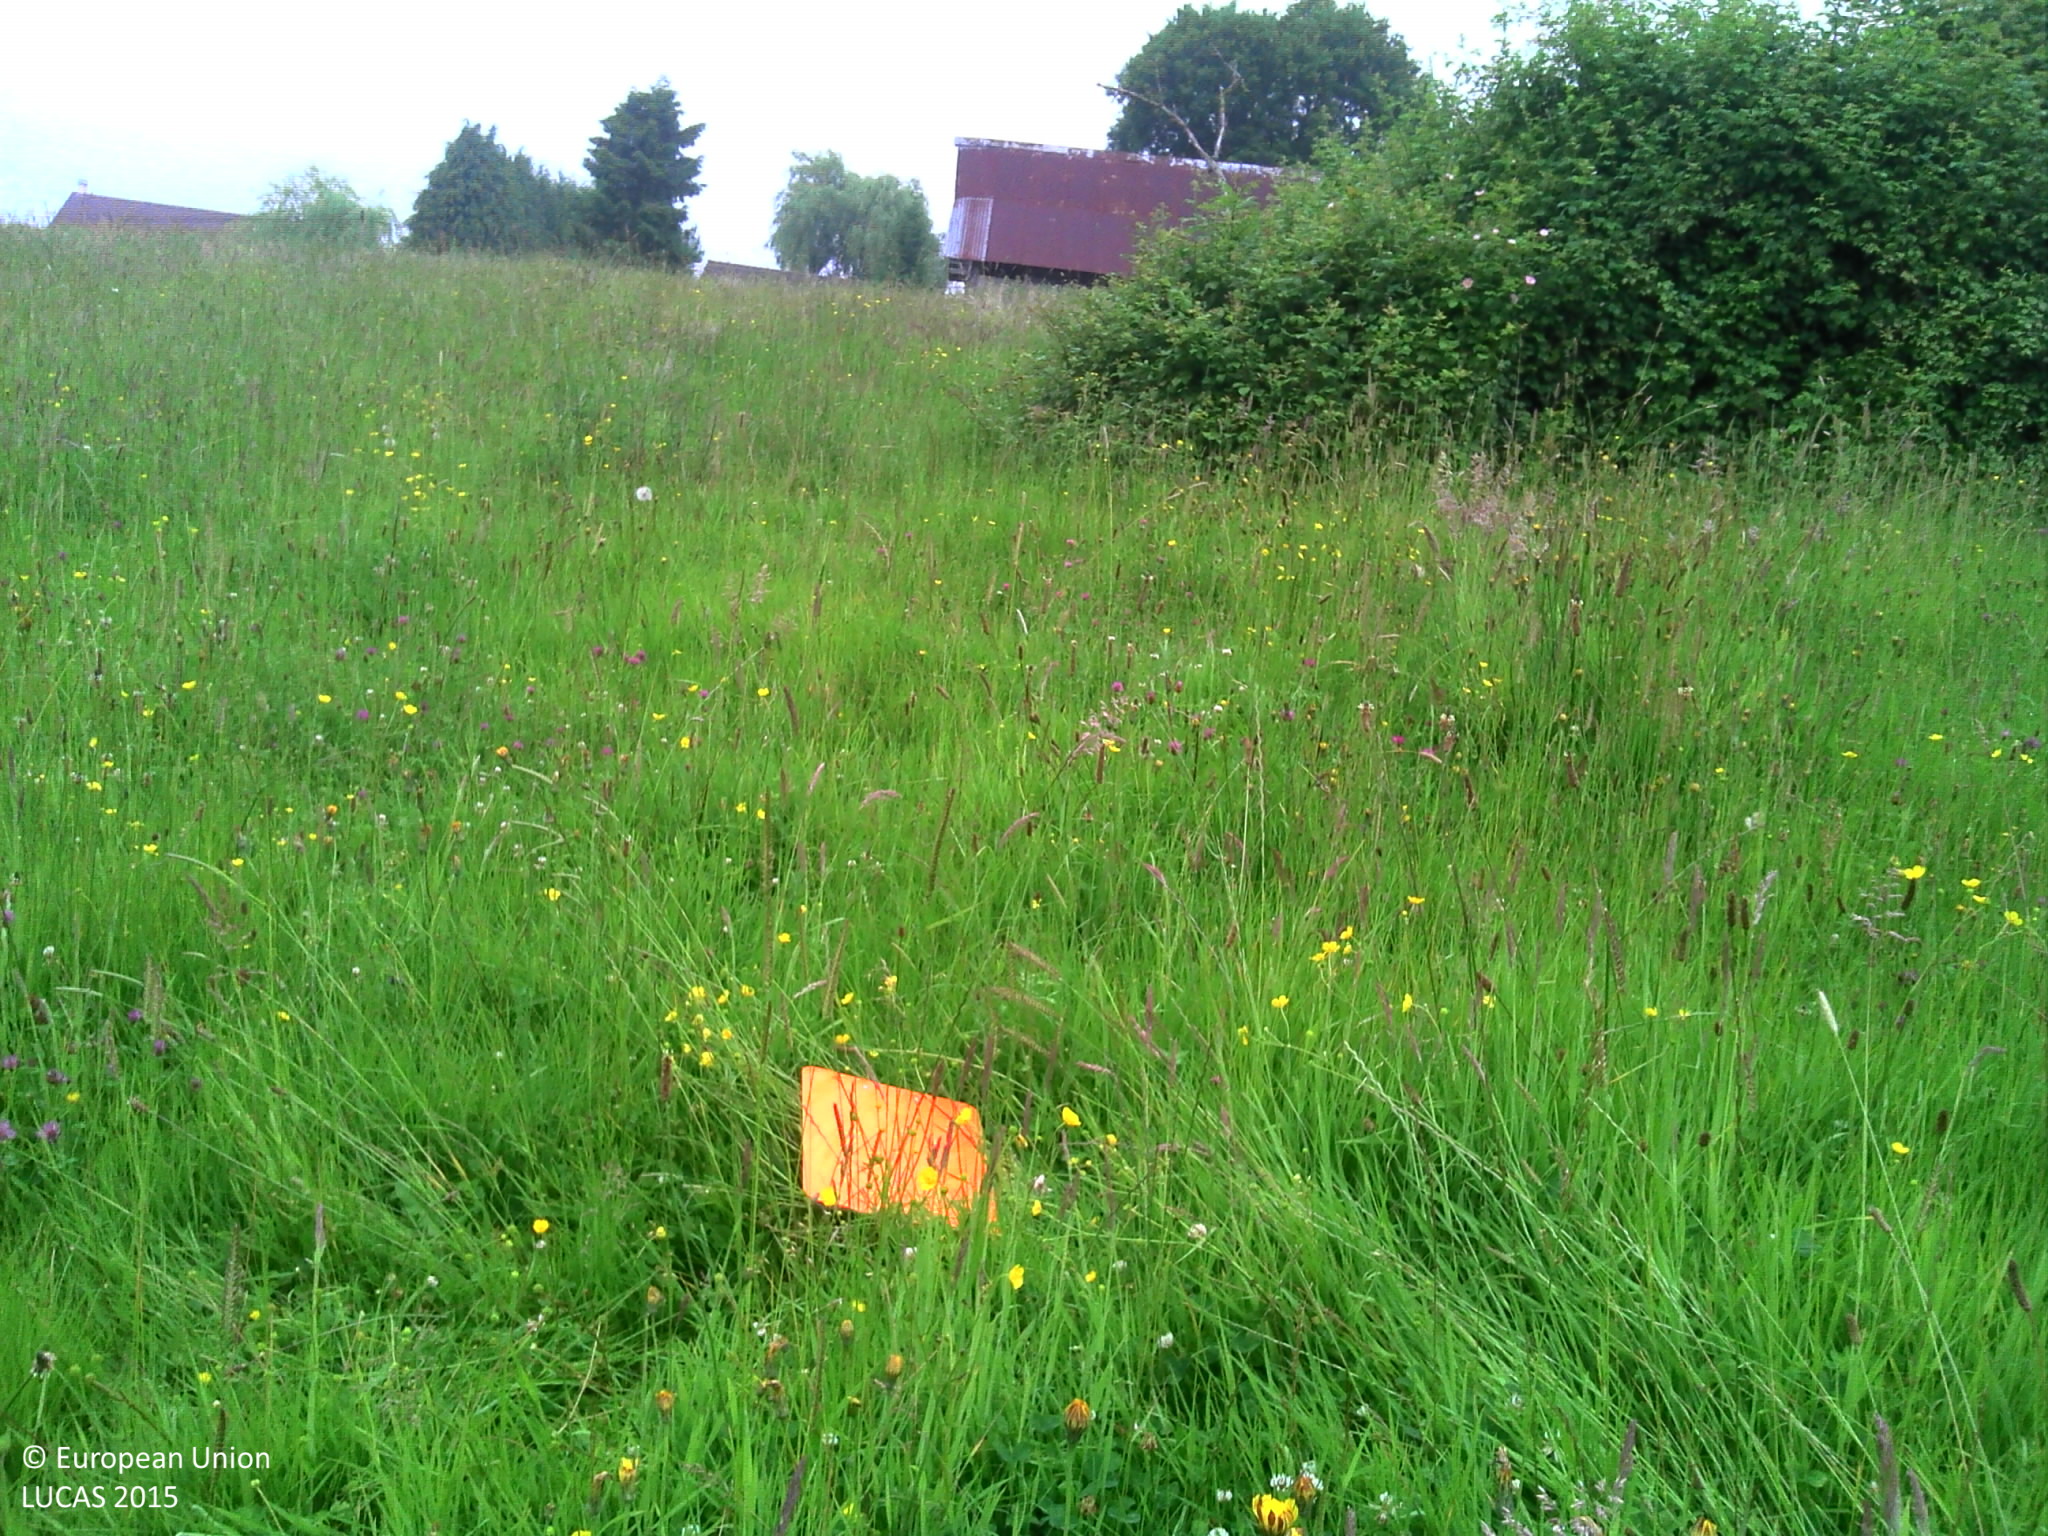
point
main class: Grassland
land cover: Grassland with sparse tree/shrub cover
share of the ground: > 75 %
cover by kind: herbaceous plants 95 %, broadleaved forest trees 5 %
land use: Agriculture (excluding fallow land and kitchen gardens)
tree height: > 5 m
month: June
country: FR
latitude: 49.2395
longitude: 0.0388
